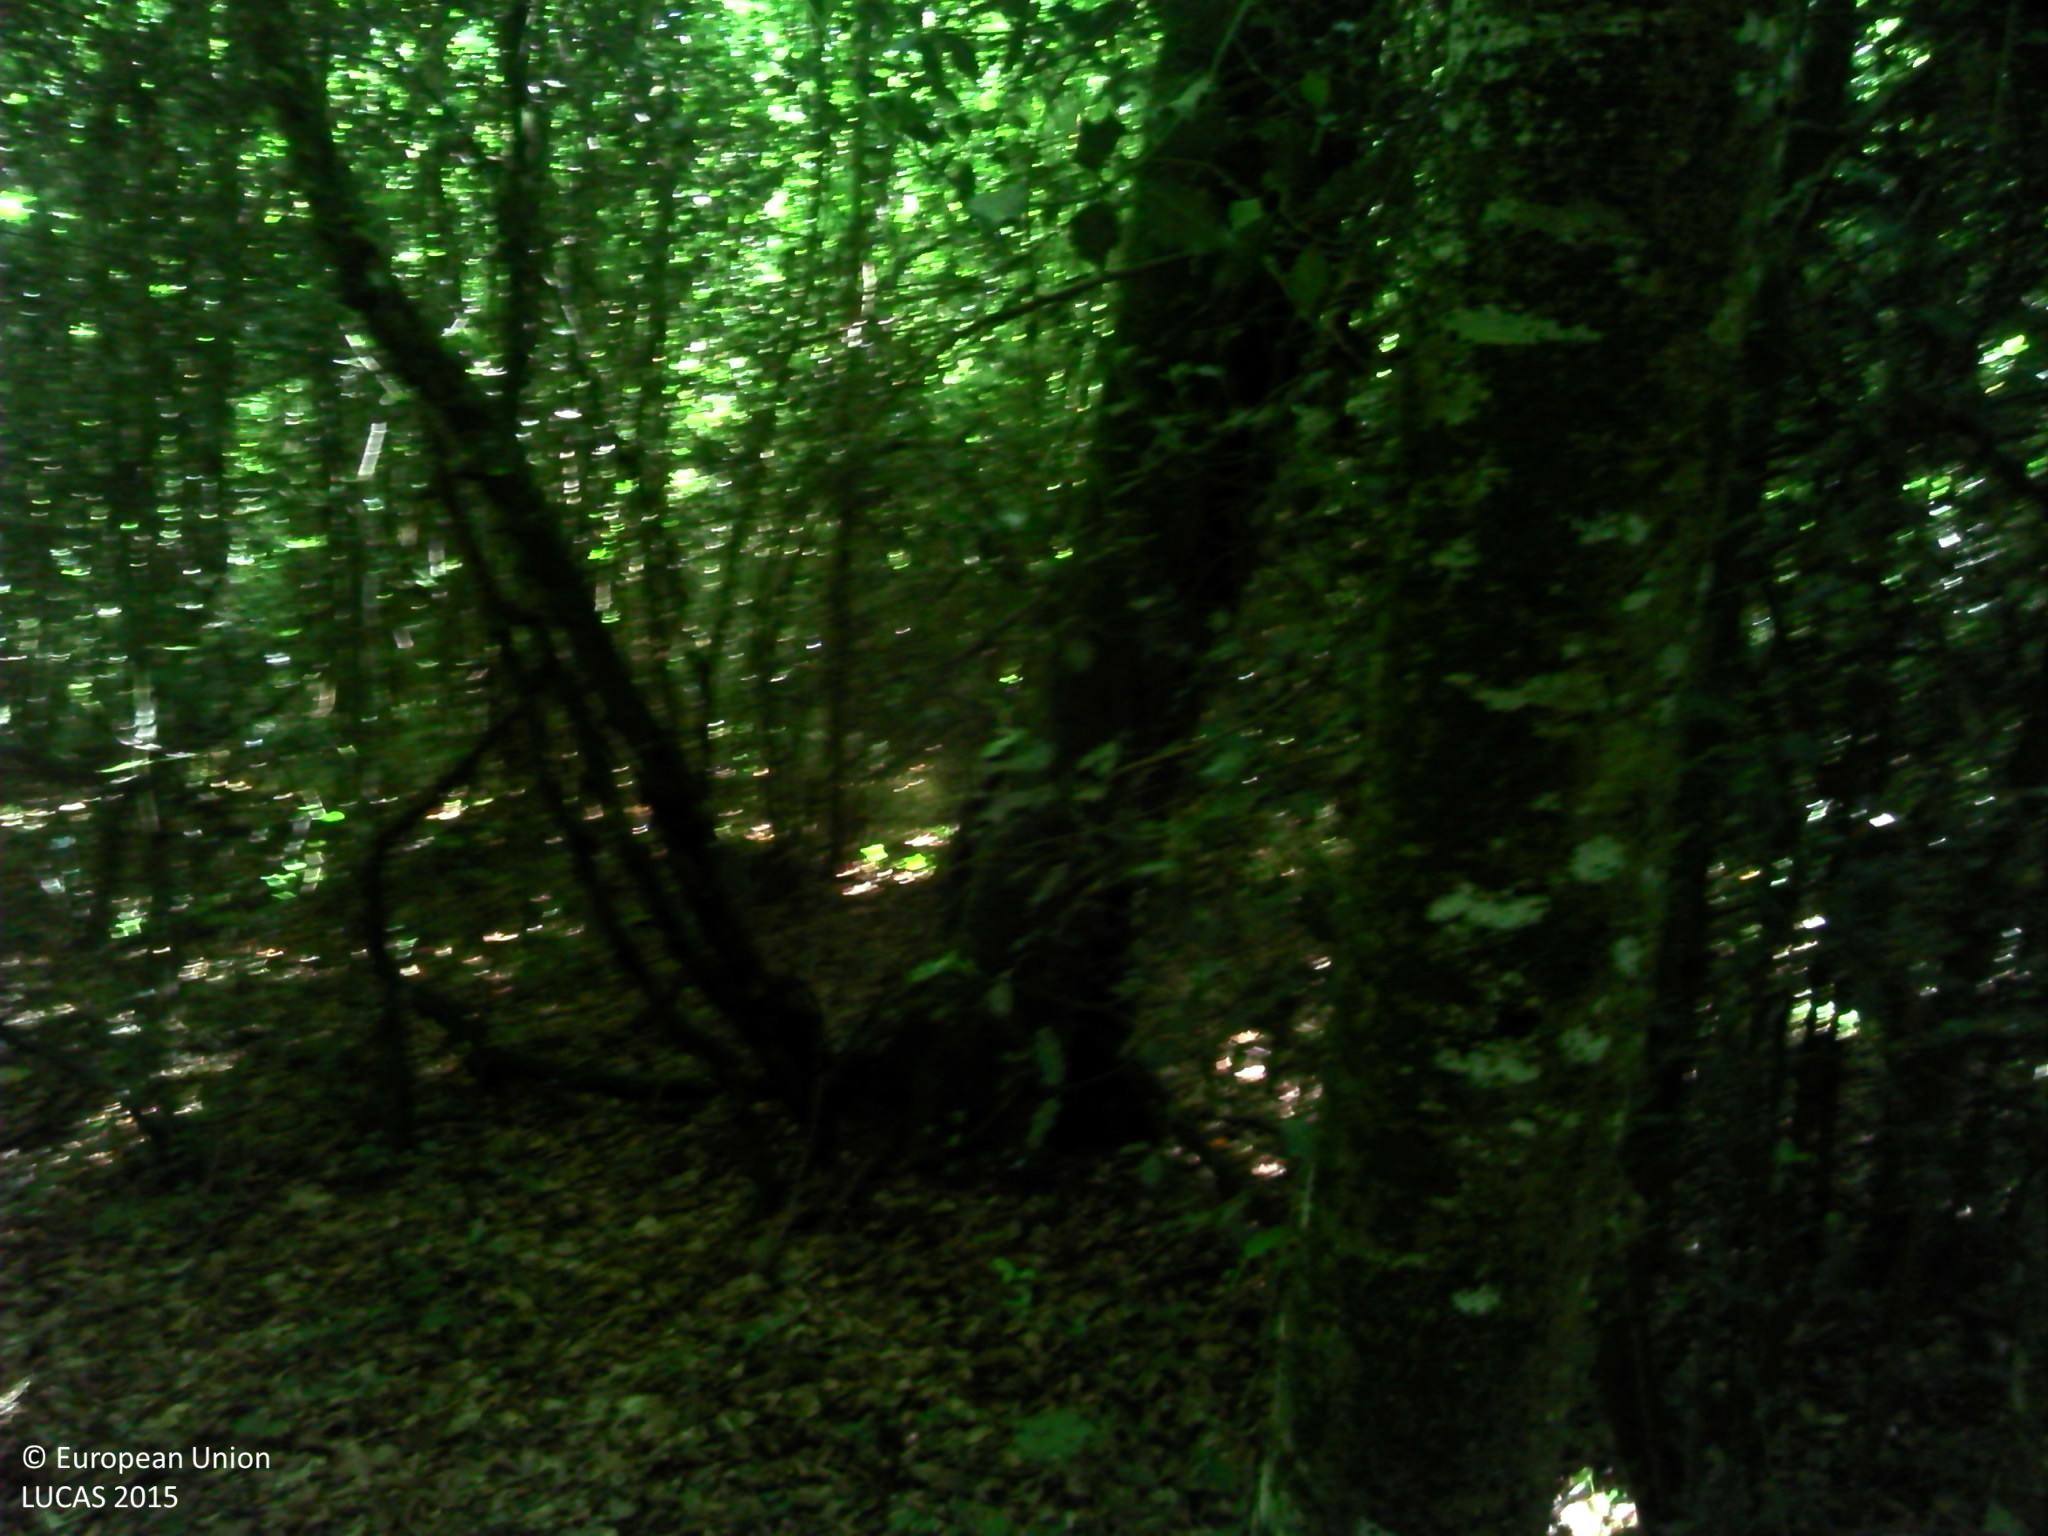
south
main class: Woodland
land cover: Broadleaved woodland
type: beech forest
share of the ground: > 75 %
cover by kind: broadleaved forest trees 100 %
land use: Forestry
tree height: > 5 m
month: July
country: FR
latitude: 46.1742
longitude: 1.7151
